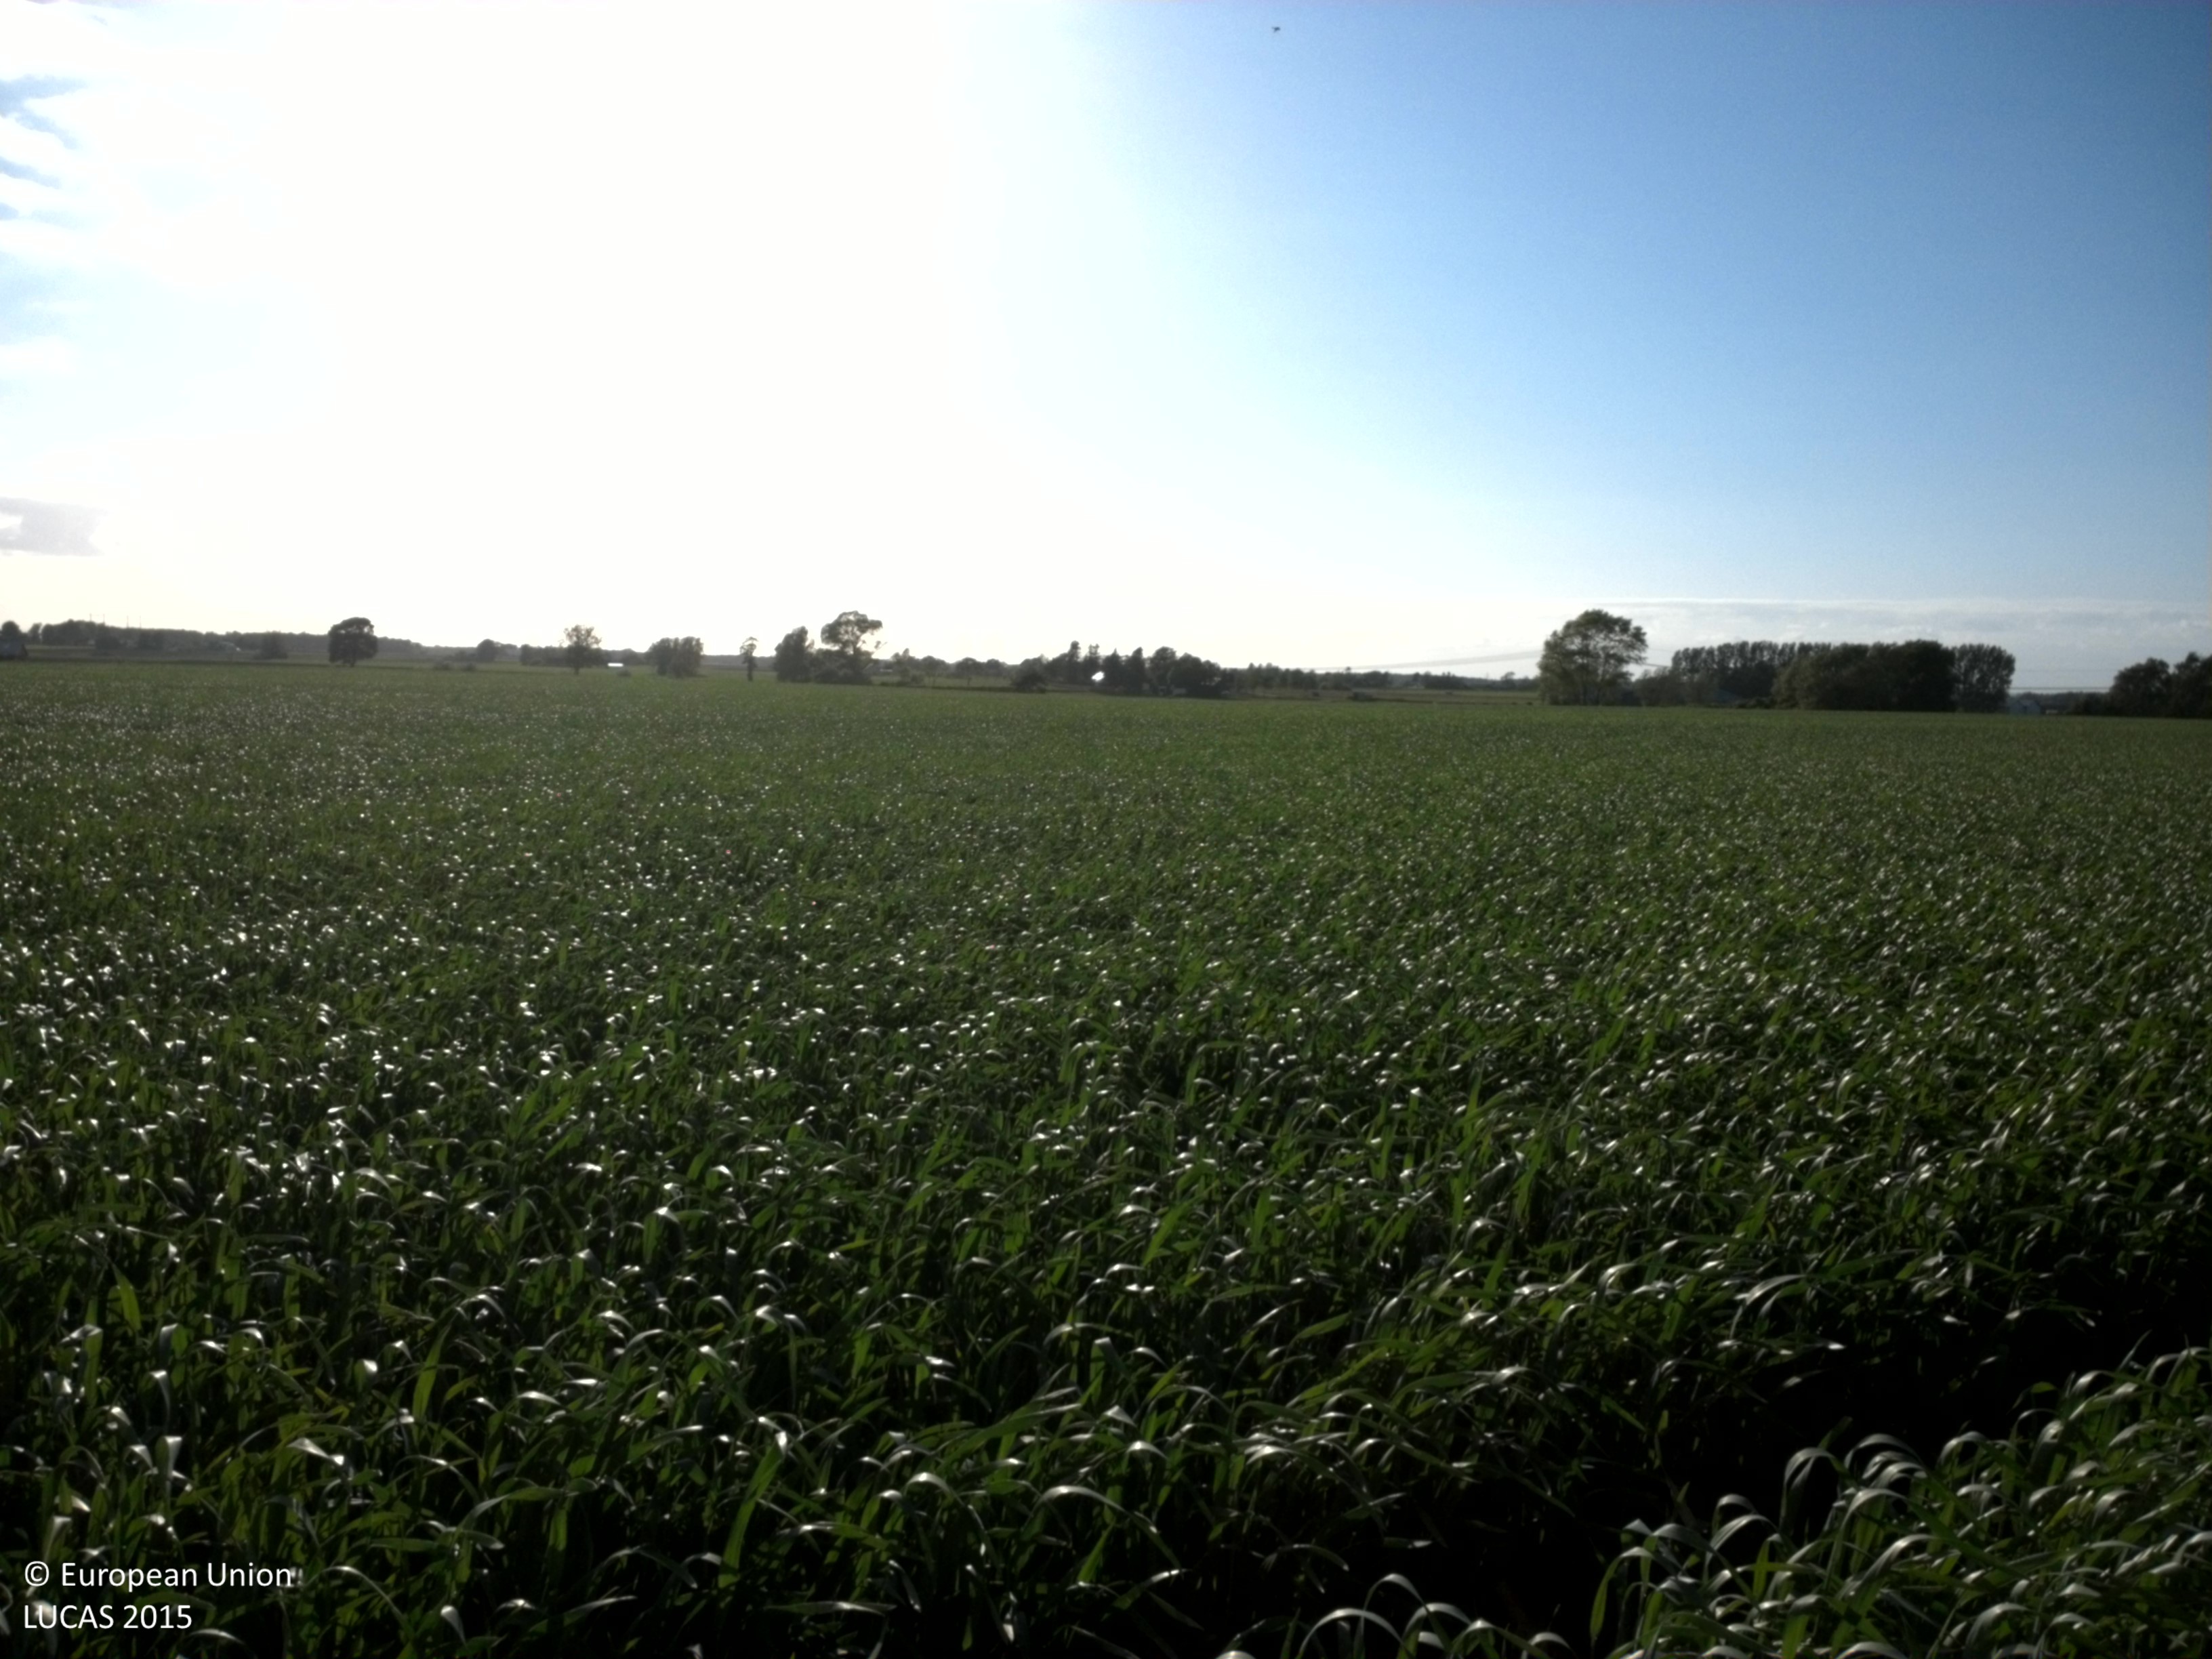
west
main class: Cropland
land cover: Common wheat
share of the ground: > 75 %
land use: Agriculture (excluding fallow land and kitchen gardens)
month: June
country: SE
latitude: 55.7919
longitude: 13.0441
